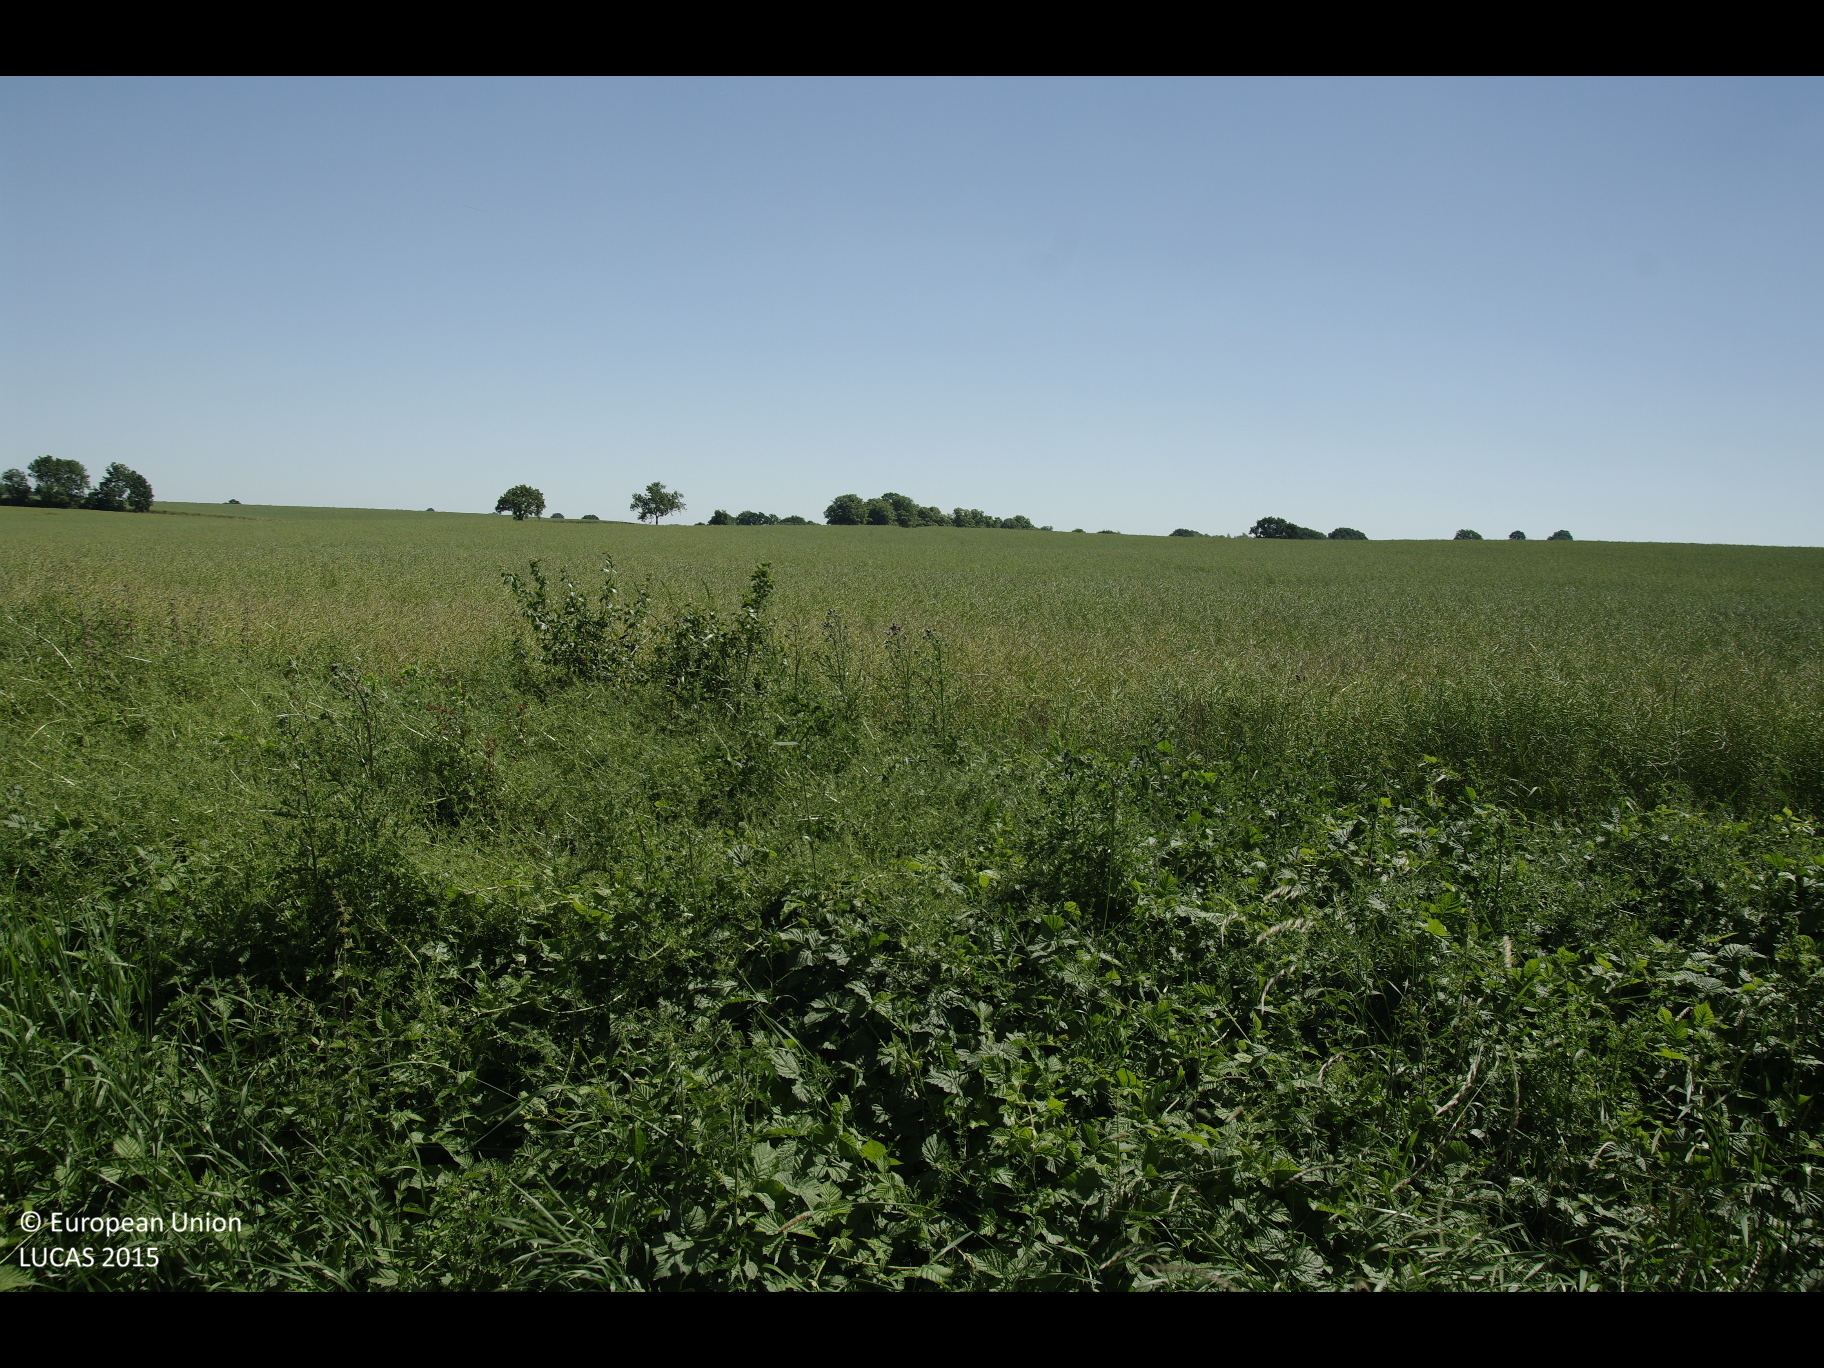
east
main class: Cropland
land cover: Rape and turnip rape
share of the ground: > 75 %
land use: Agriculture (excluding fallow land and kitchen gardens)
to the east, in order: Rape and turnip rape
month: July
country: DE
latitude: 53.7574
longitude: 10.9854
